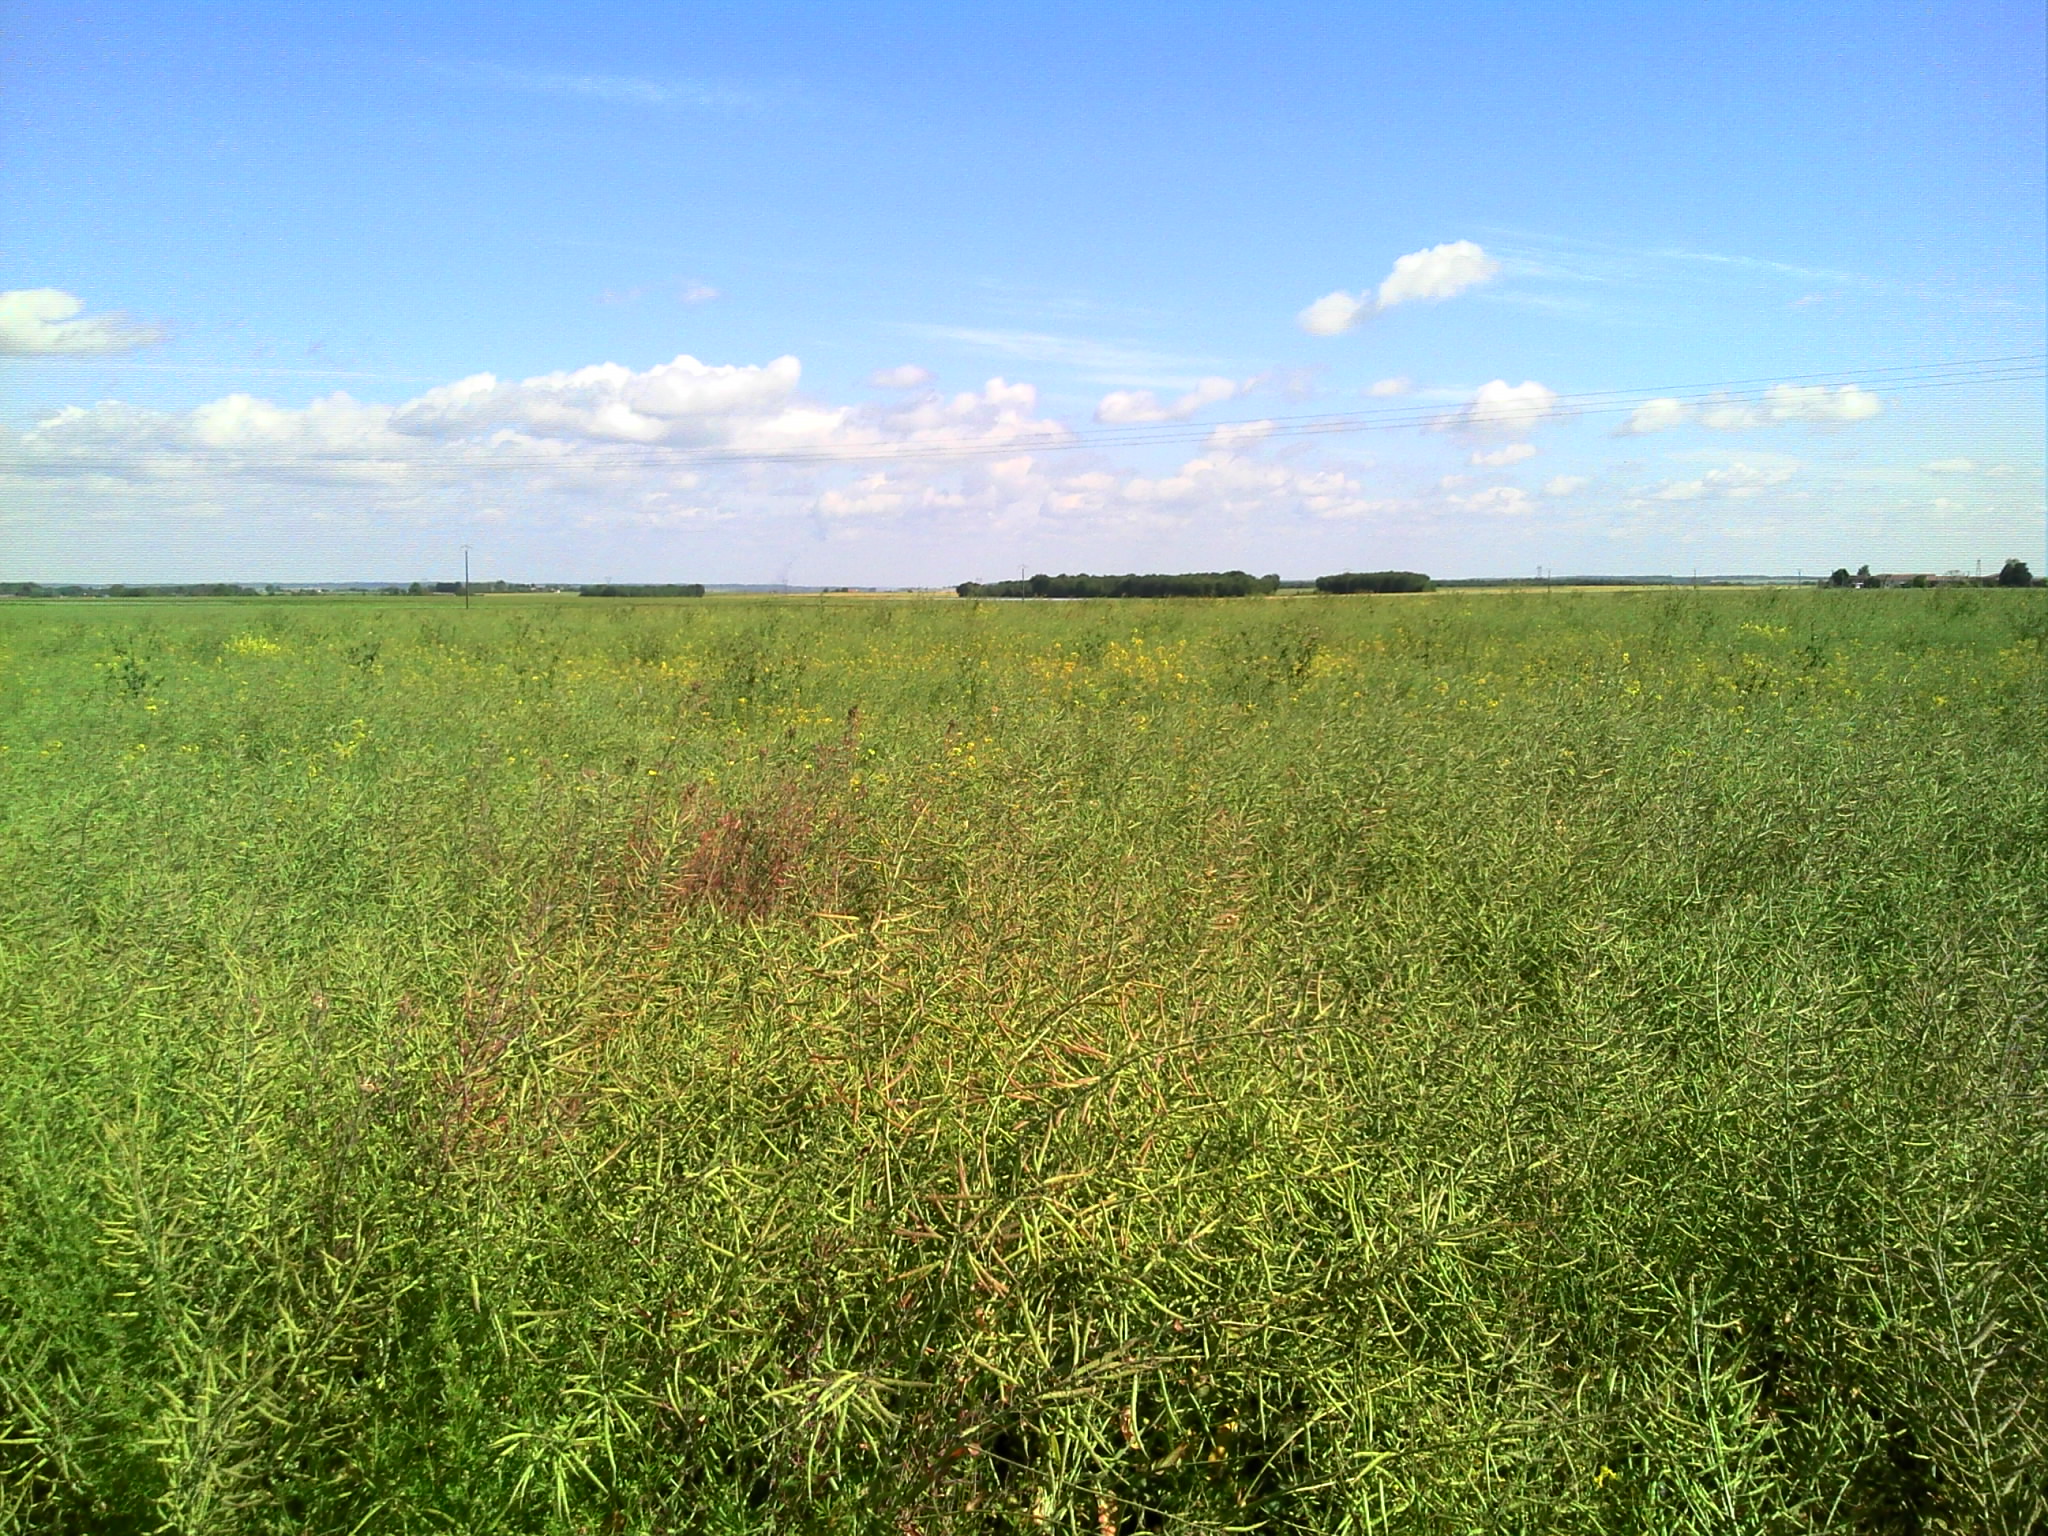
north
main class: Cropland
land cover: Rape and turnip rape
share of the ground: > 75 %
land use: Agriculture (excluding fallow land and kitchen gardens)
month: May
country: FR
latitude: 47.0247
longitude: 0.2020
